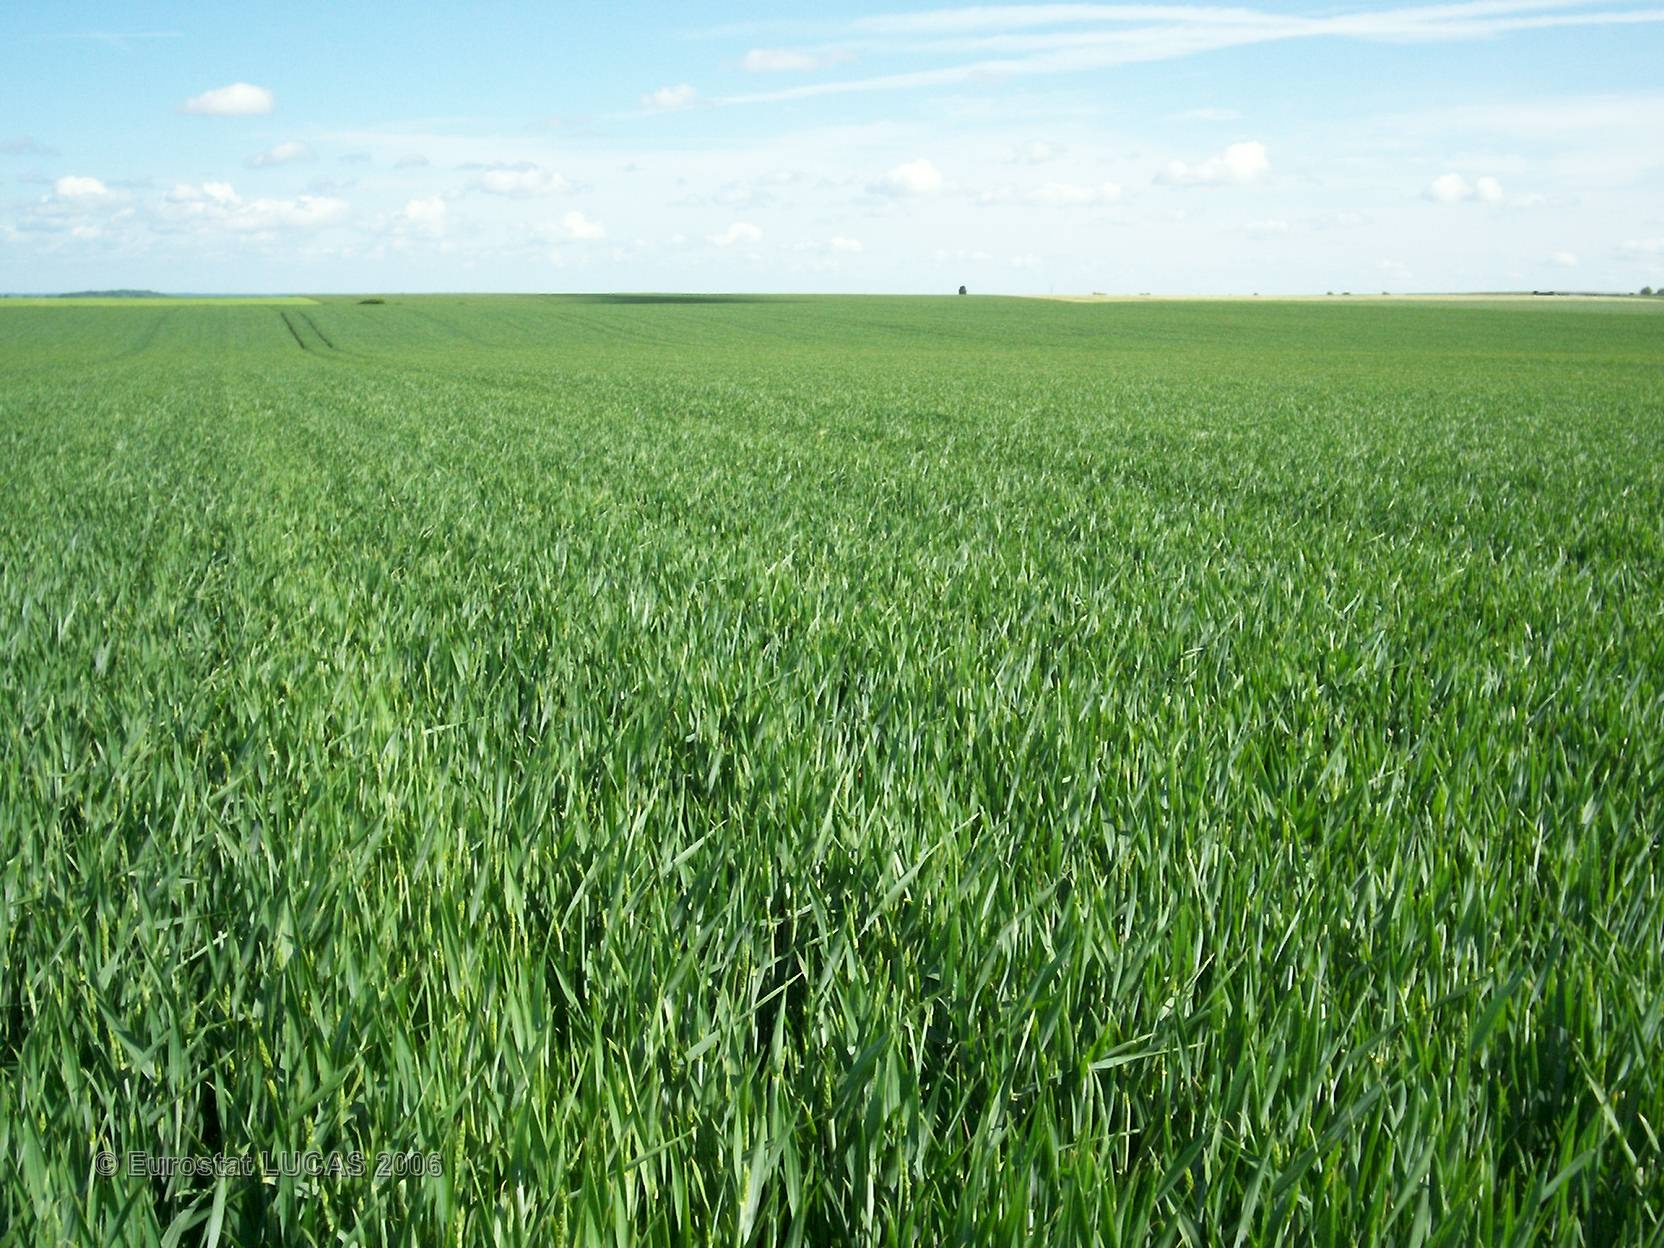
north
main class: Cropland
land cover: Common wheat
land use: Agriculture (excluding fallow land and kitchen gardens)
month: May
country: FR
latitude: 48.1584
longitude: 4.4993
